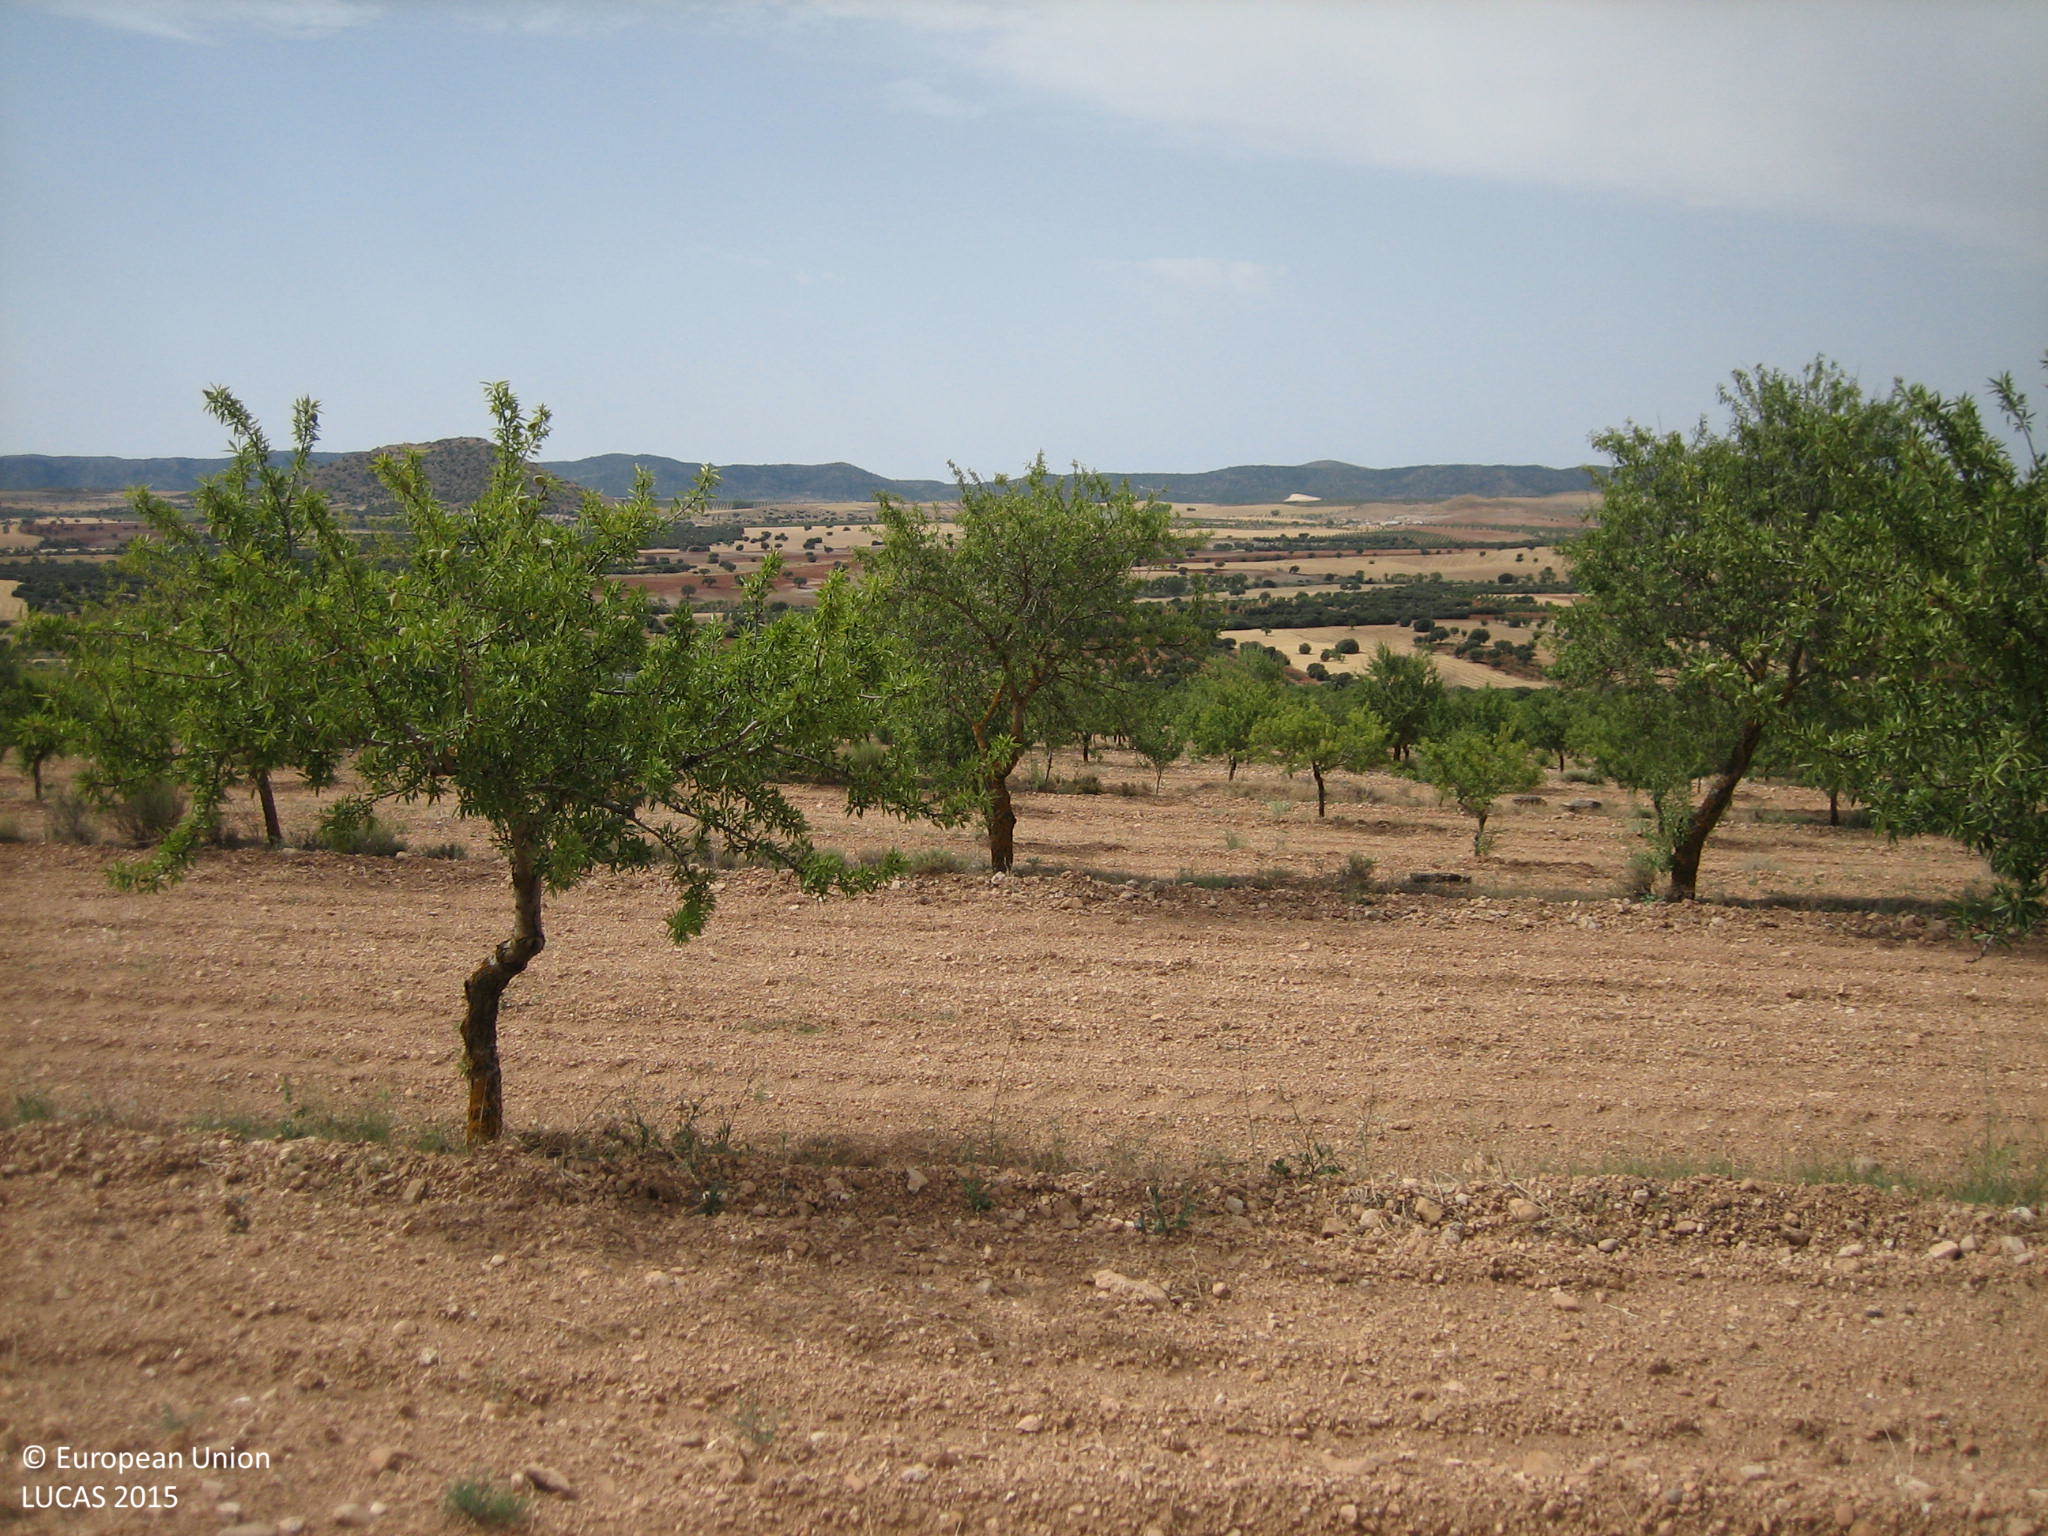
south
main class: Cropland
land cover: Nuts trees
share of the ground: < 10 %
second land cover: Other bare soil
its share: > 75 %
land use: Agriculture (excluding fallow land and kitchen gardens)
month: July
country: ES
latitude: 37.6027
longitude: -2.3206
